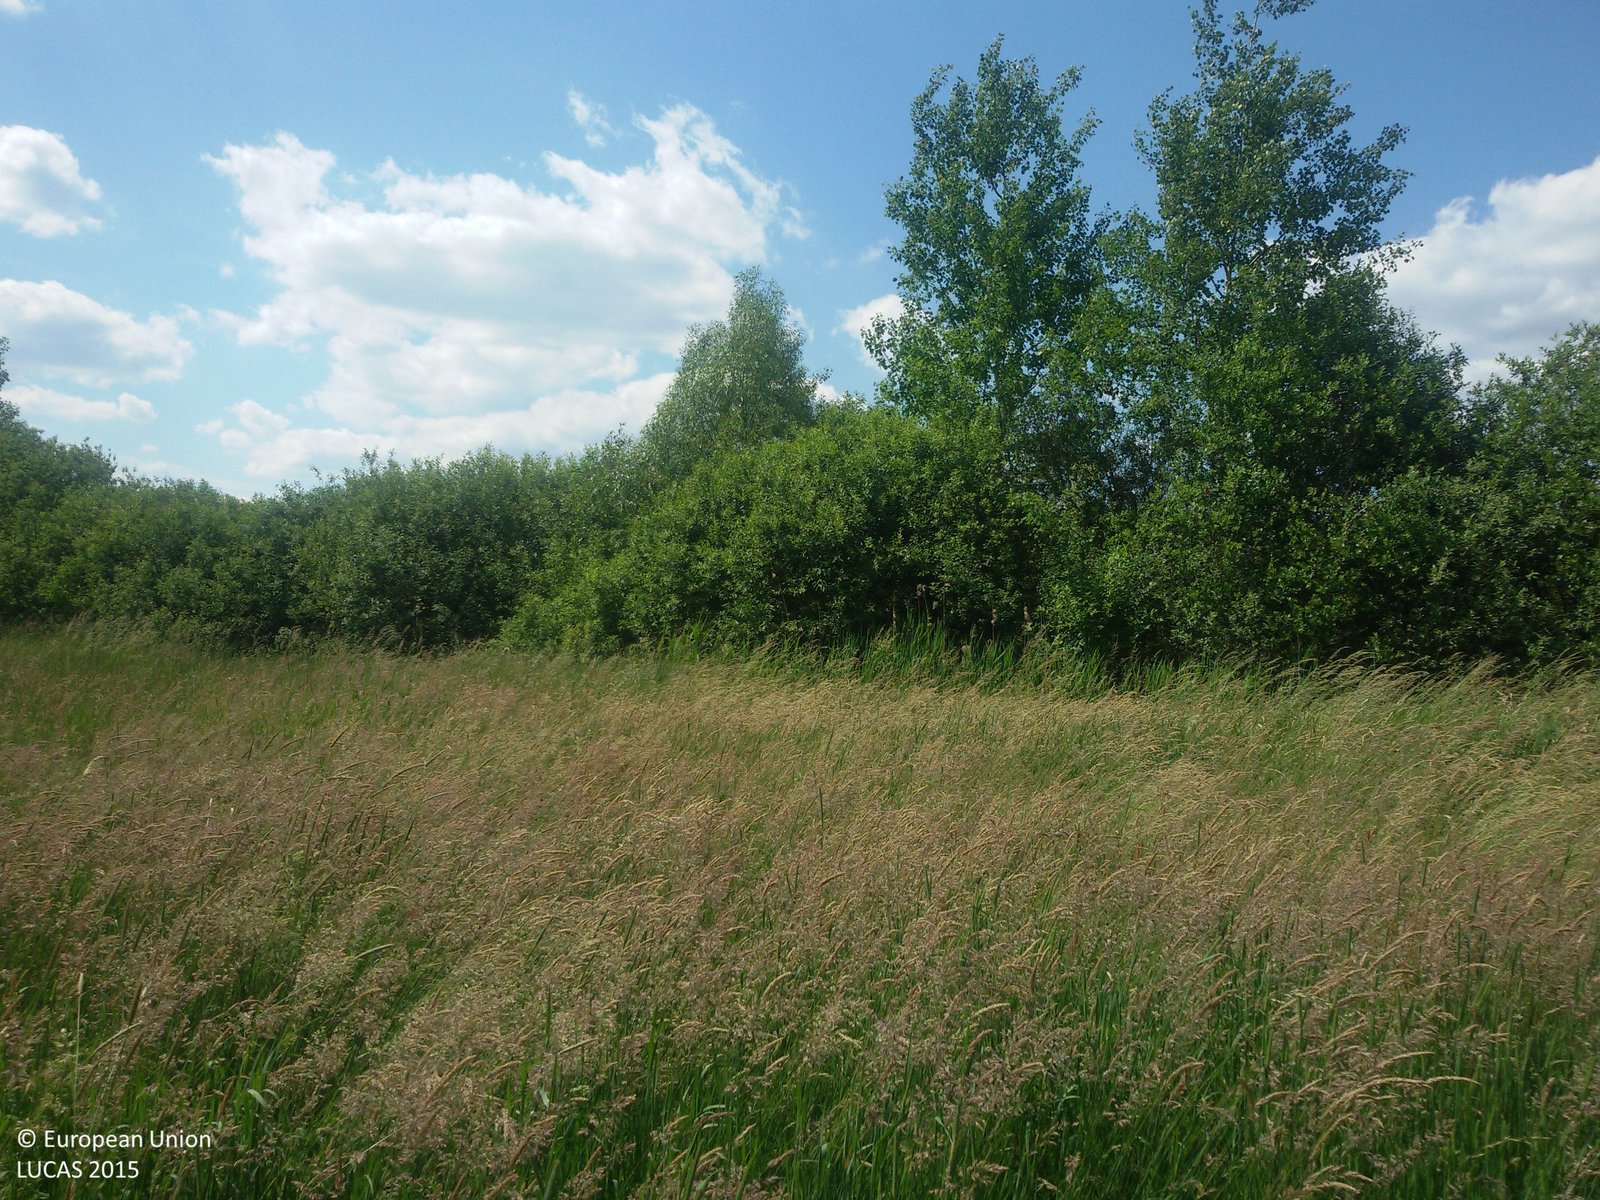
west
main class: Grassland
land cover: Grassland without tree/shrub cover
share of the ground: > 75 %
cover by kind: herbaceous plants 100 %
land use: Agriculture (excluding fallow land and kitchen gardens)
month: June
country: PL
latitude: 51.5703
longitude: 22.8115
